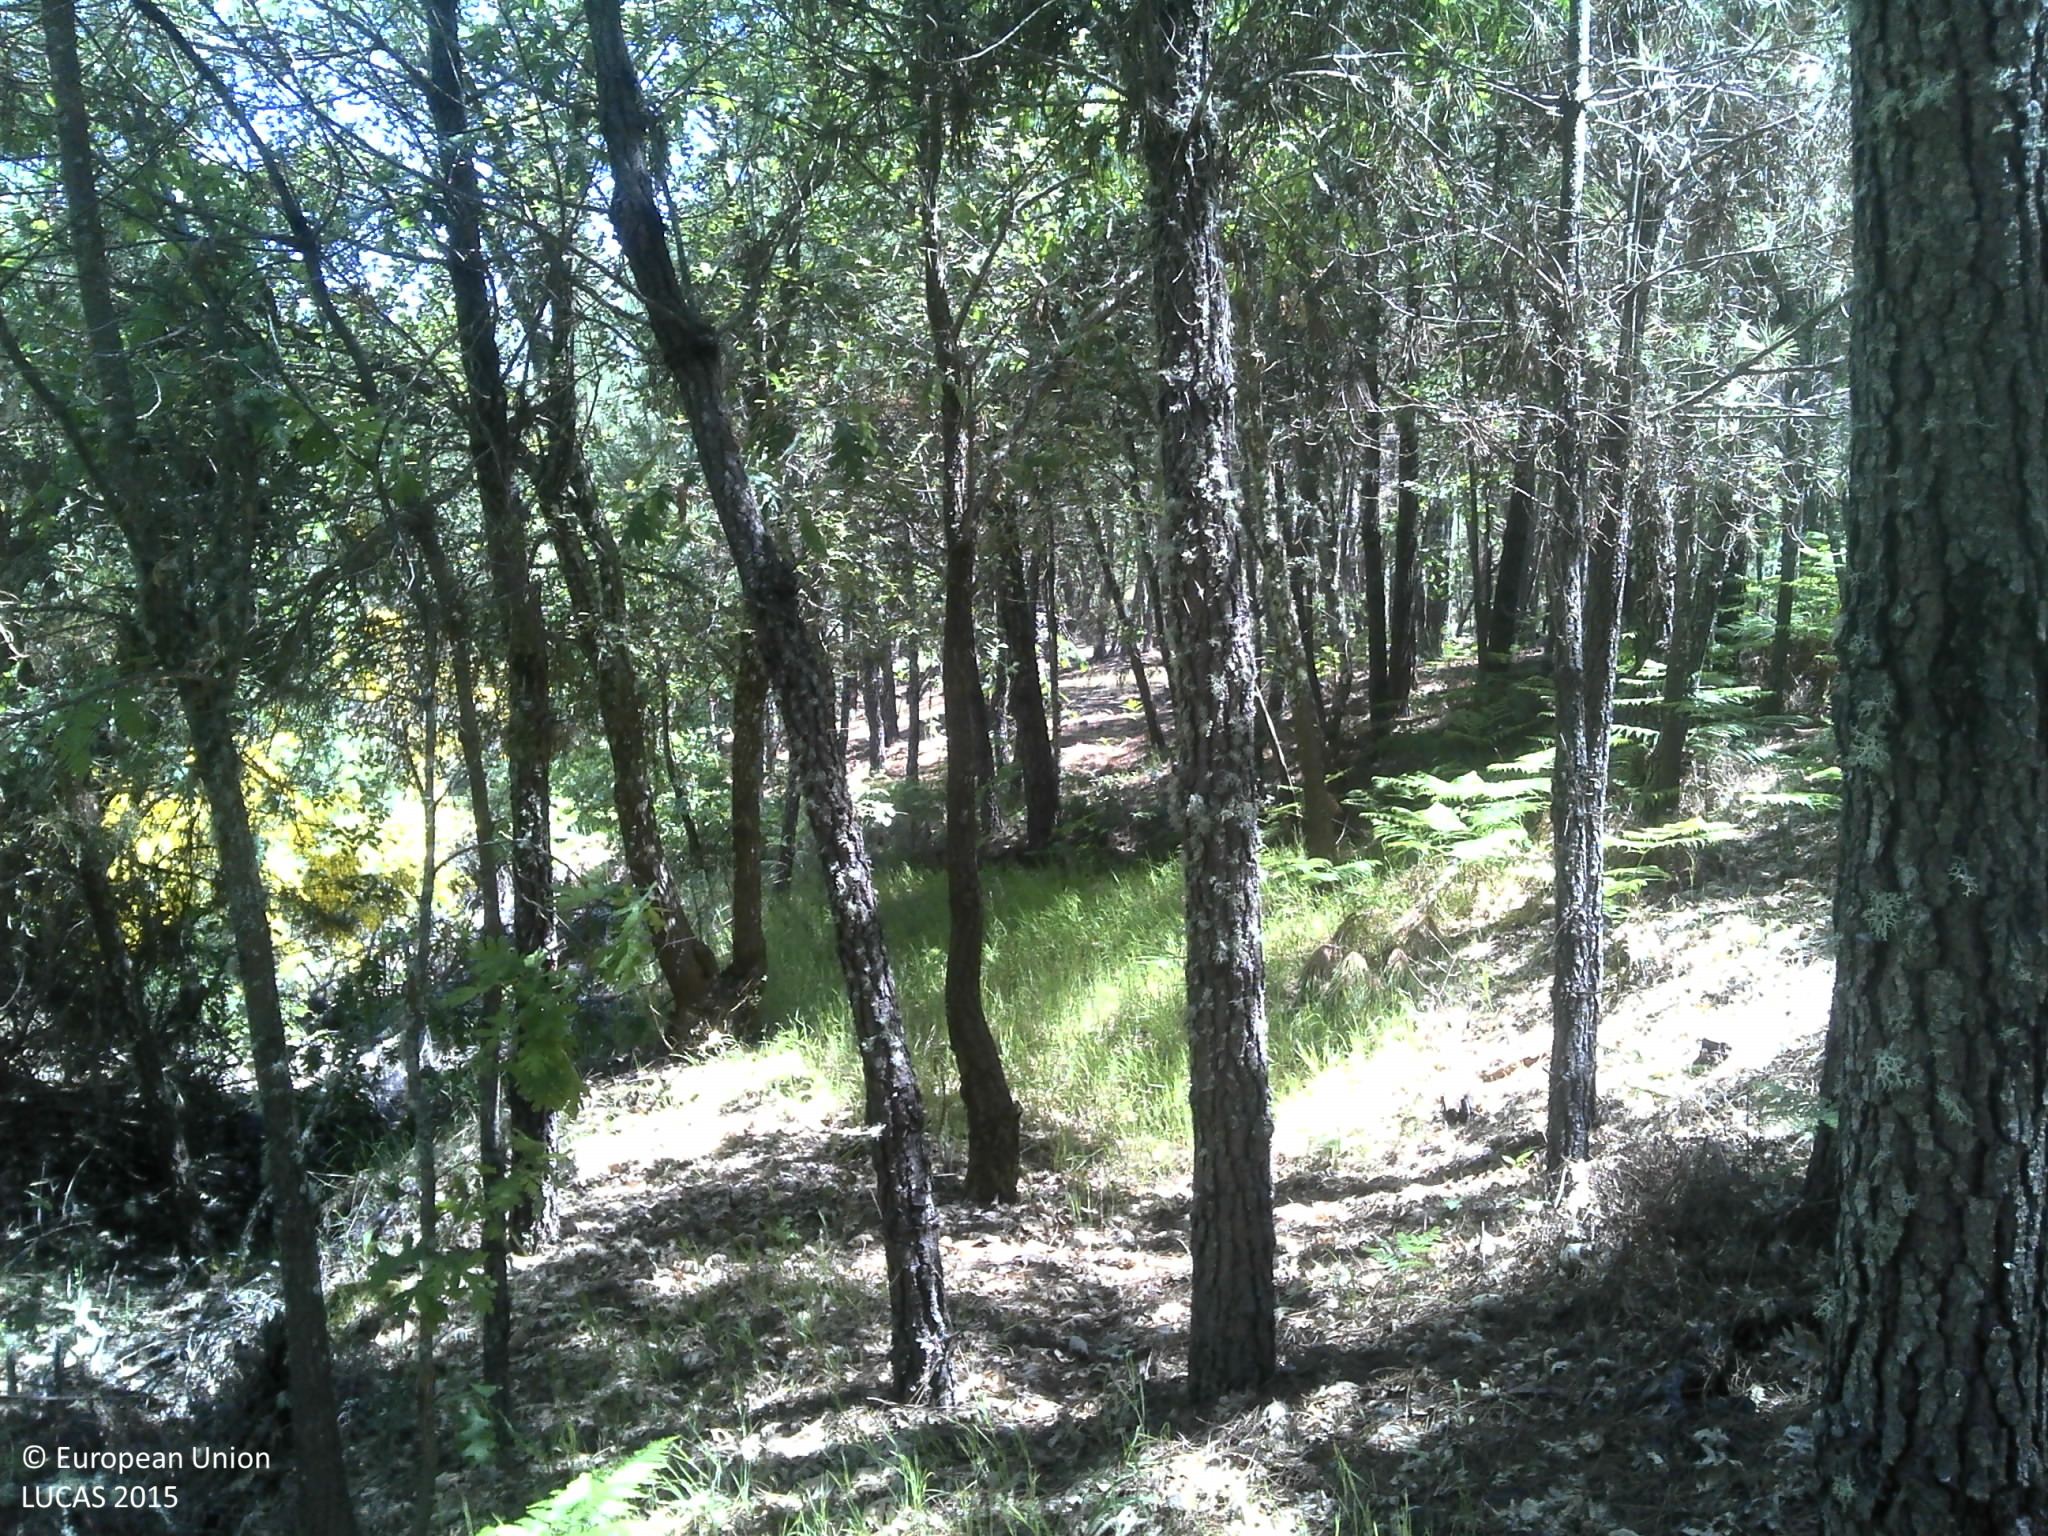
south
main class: Woodland
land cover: Pine dominated coniferous woodland
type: coniferous forest of the mediterranean region
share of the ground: 50 - 75 %
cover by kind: coniferous forest trees 75 %, unconsolidated bare surface 20 %, herbaceous plants 5 %
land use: Forestry
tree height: > 5 m
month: May
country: PT
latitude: 40.5014
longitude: -7.2261
